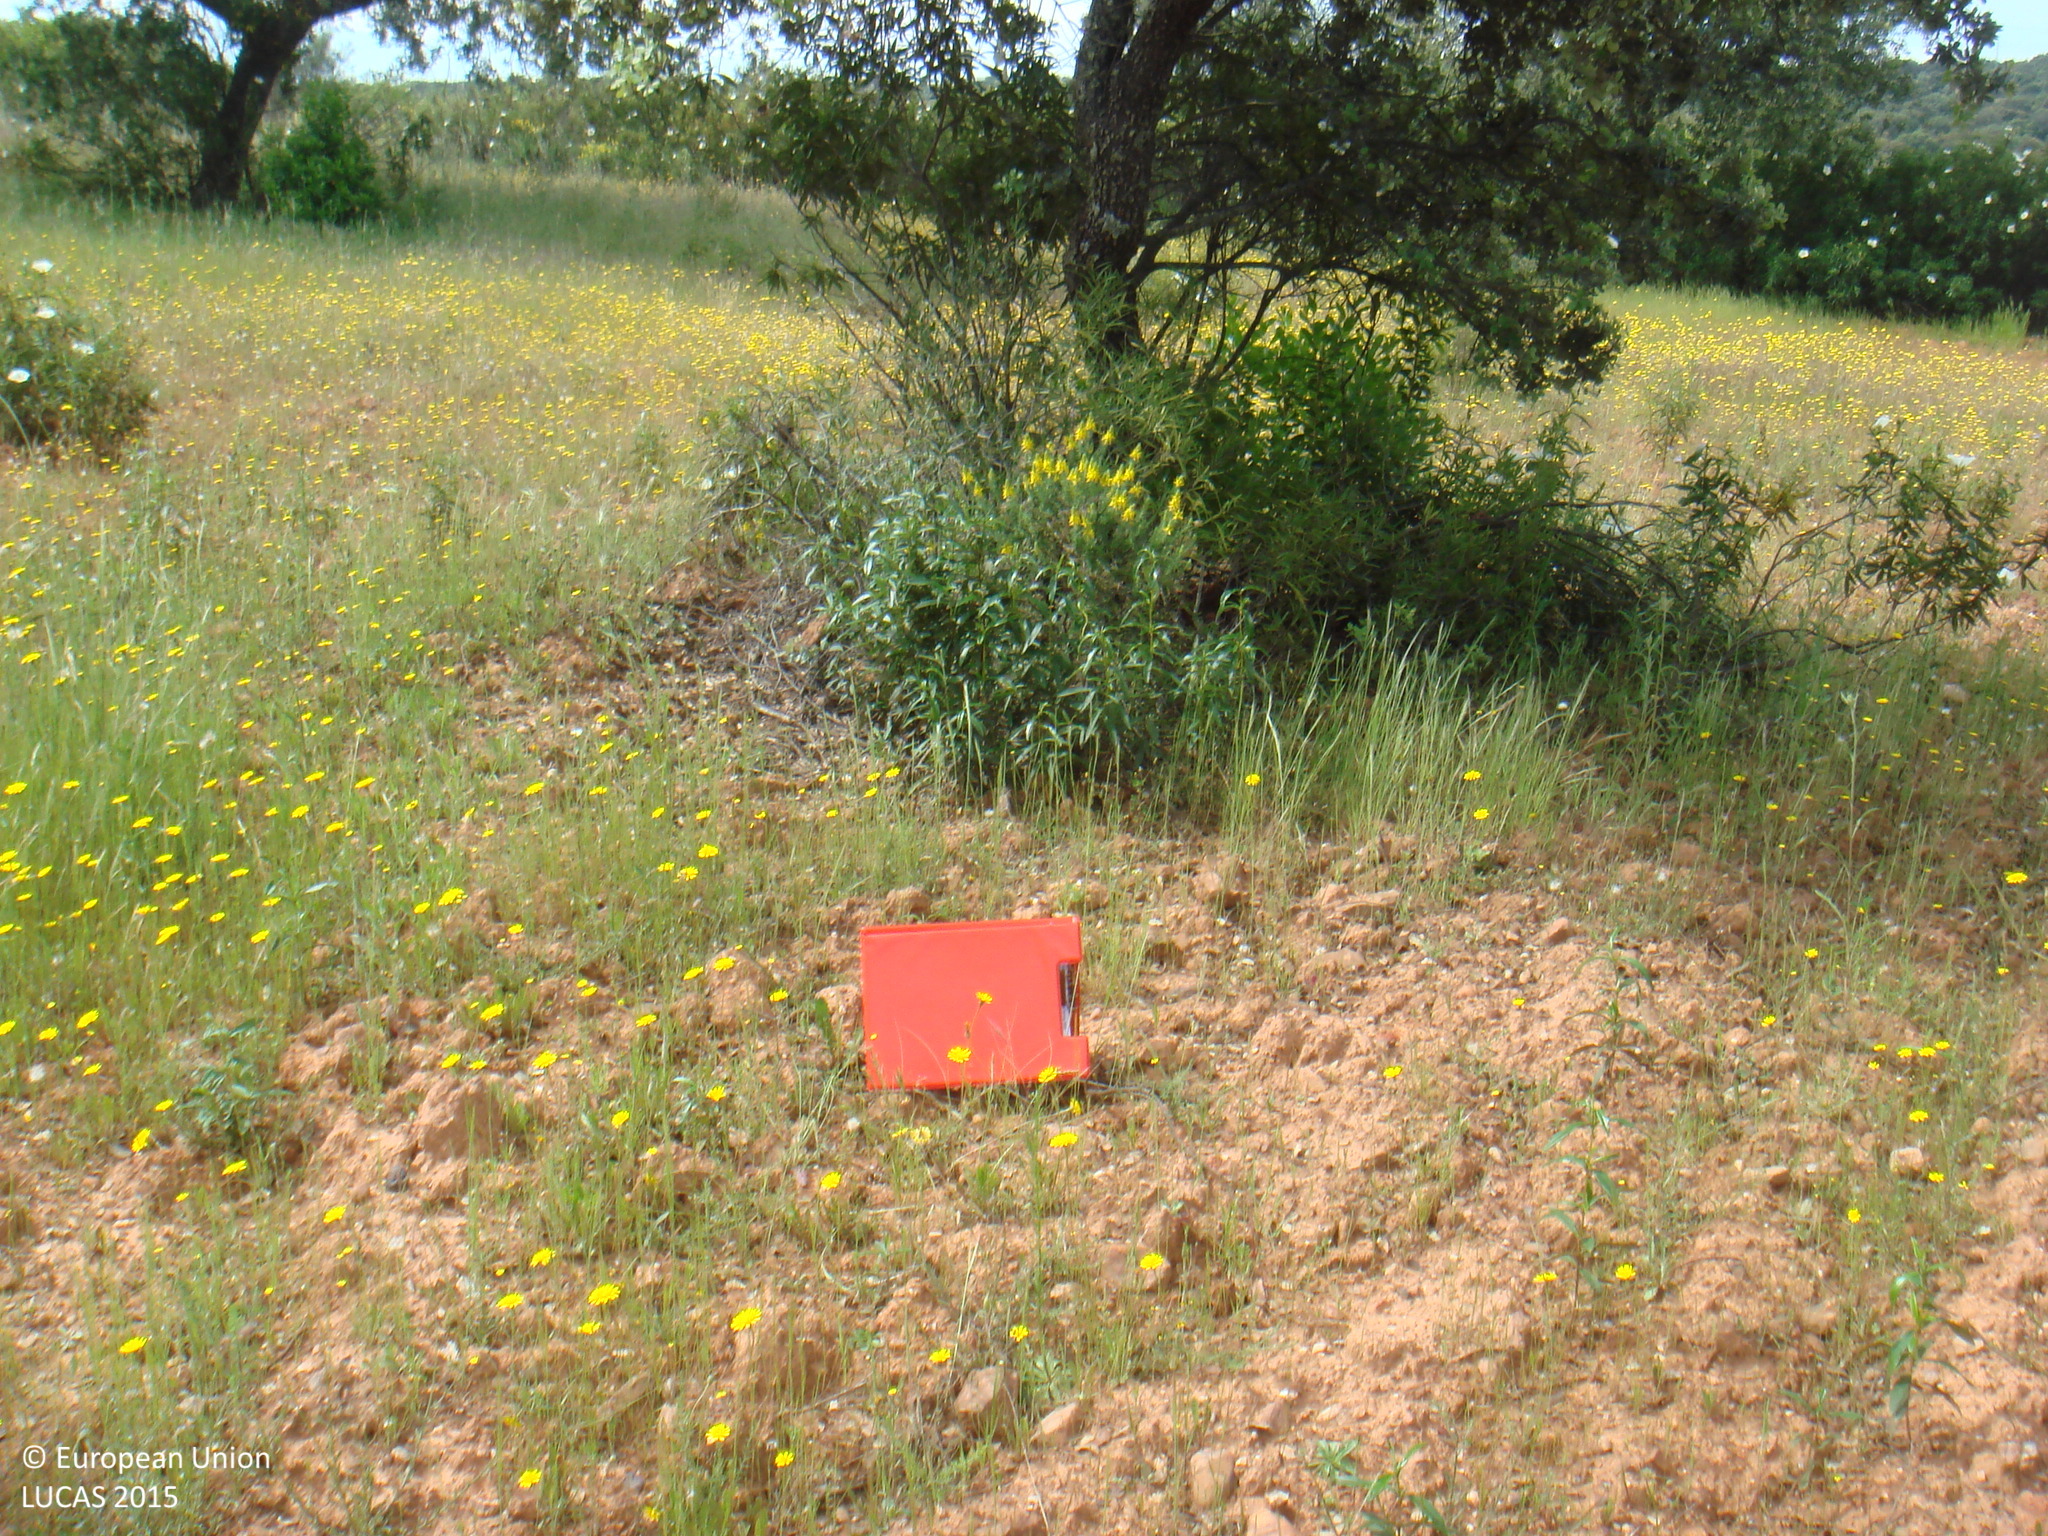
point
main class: Woodland
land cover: Broadleaved woodland
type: broadleaved evergreen forest
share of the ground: 25 - 50 %
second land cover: Shrubland without tree cover
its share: 25 - 50 %
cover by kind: herbaceous plants 50 %, shrubs 30 %, broadleaved forest trees 20 %
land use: Forestry
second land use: Agriculture (excluding fallow land and kitchen gardens)
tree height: > 5 m
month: May
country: ES
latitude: 38.3526
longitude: -5.1204
